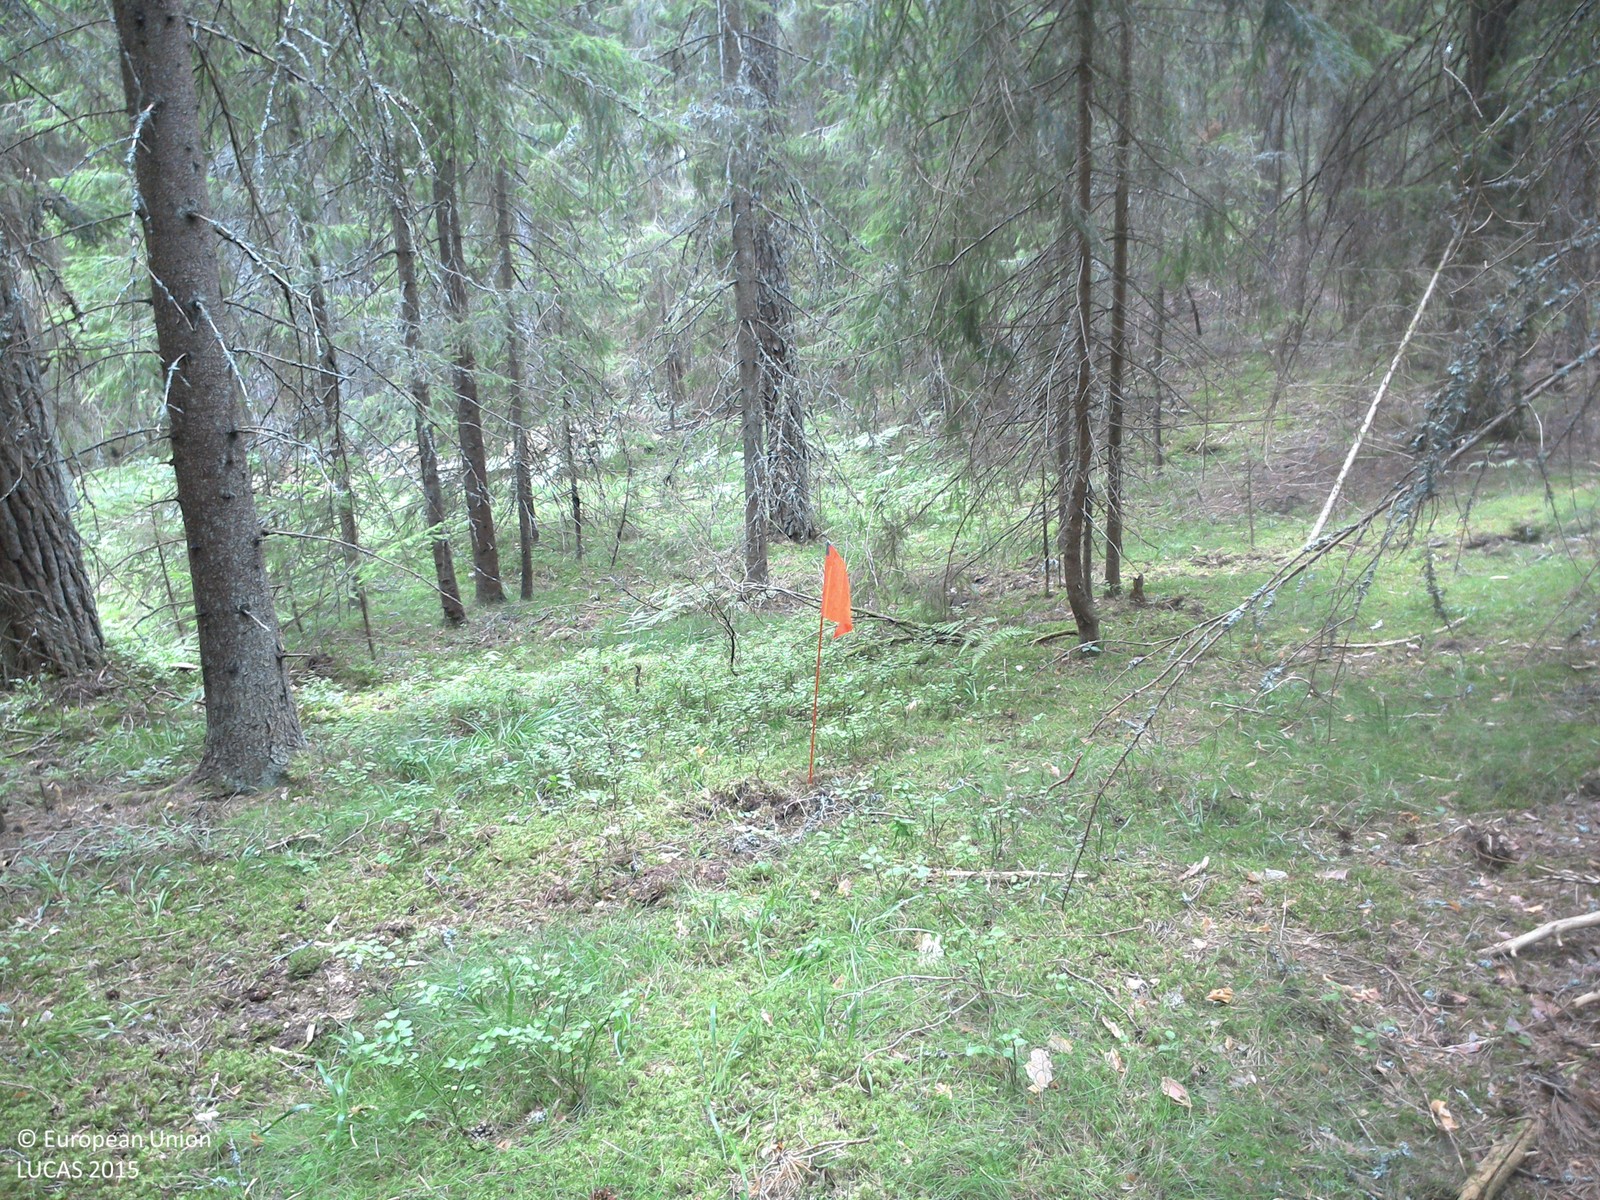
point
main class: Woodland
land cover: Spruce dominated coniferous woodland
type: boreal forest
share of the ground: 50 - 75 %
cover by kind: coniferous forest trees 60 %, herbaceous plants 20 %, lichens and mosses 20 %
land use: Forestry
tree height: > 5 m
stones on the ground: < 10 %
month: August
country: SE
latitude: 57.9811
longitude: 15.4914
